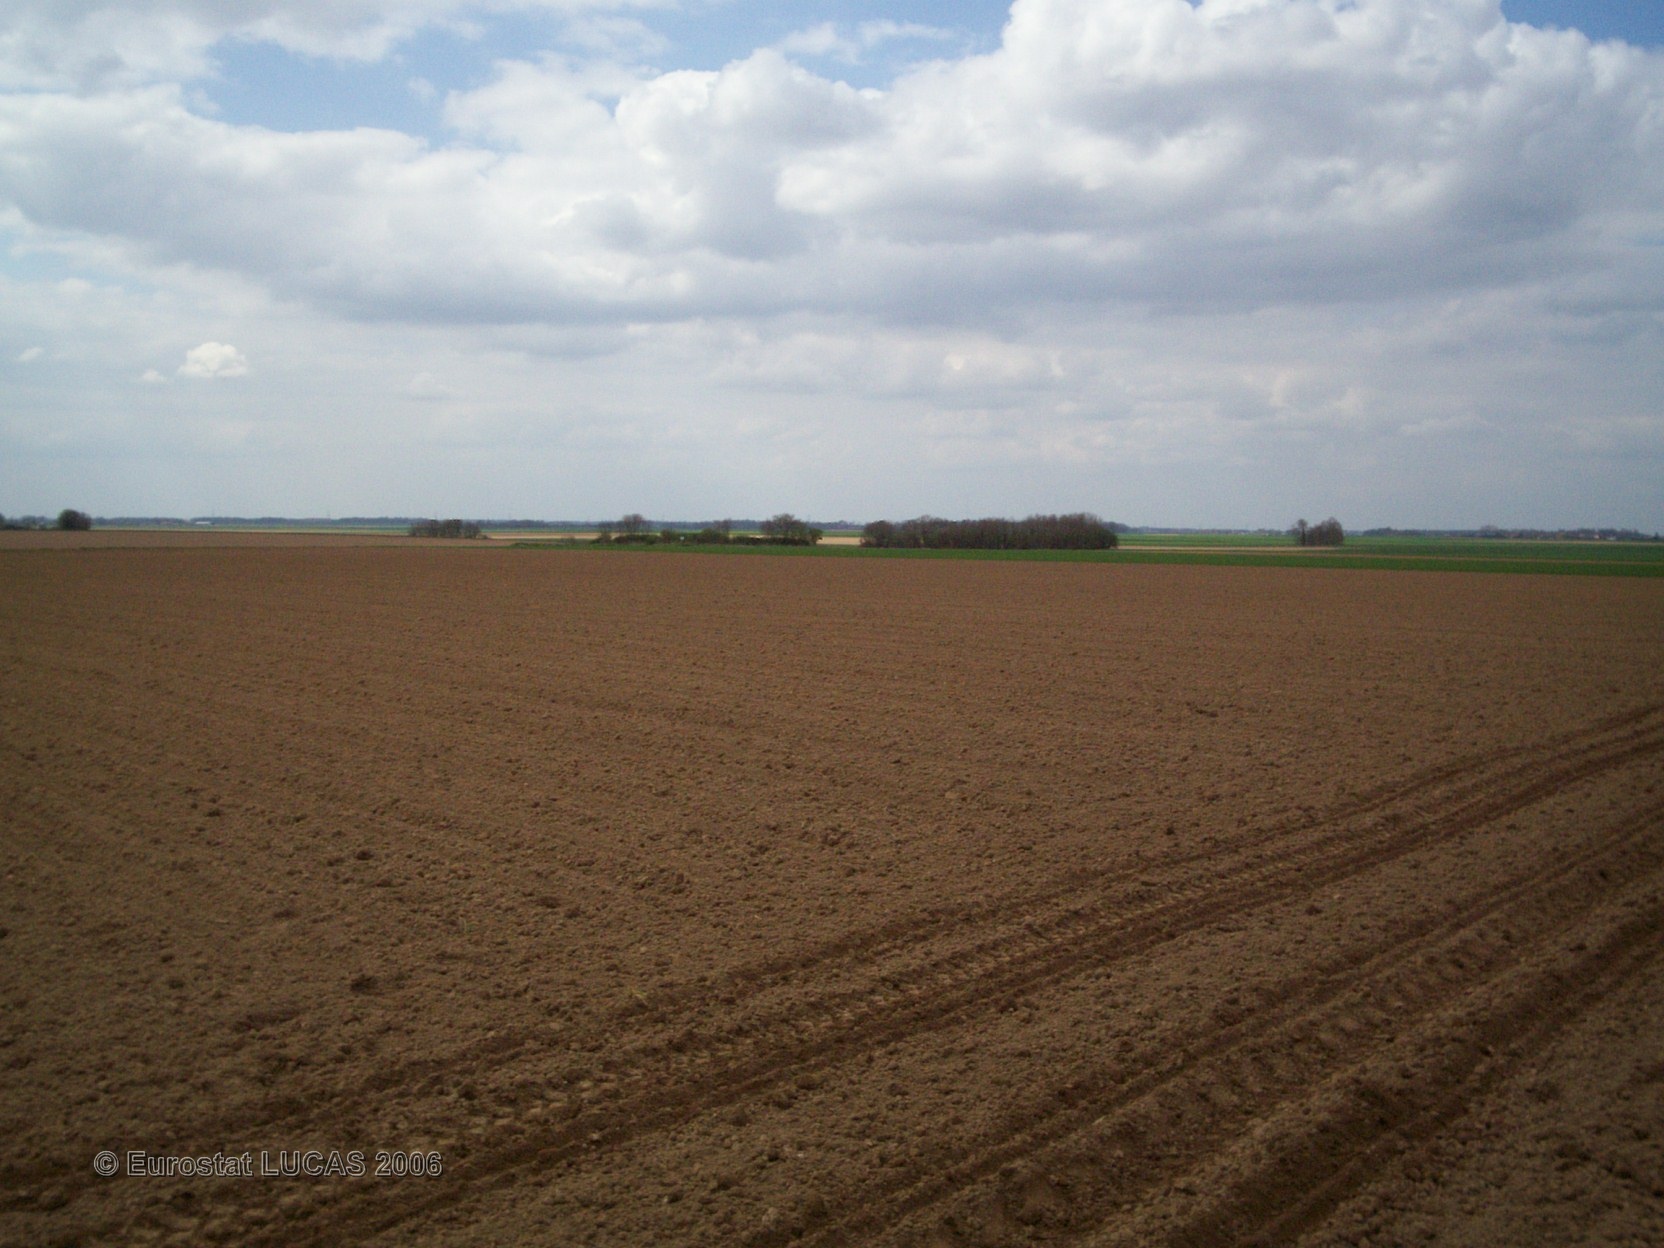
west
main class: Cropland
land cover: Maize
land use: Agriculture (excluding fallow land and kitchen gardens)
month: April
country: FR
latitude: 49.0887
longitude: 1.0369
